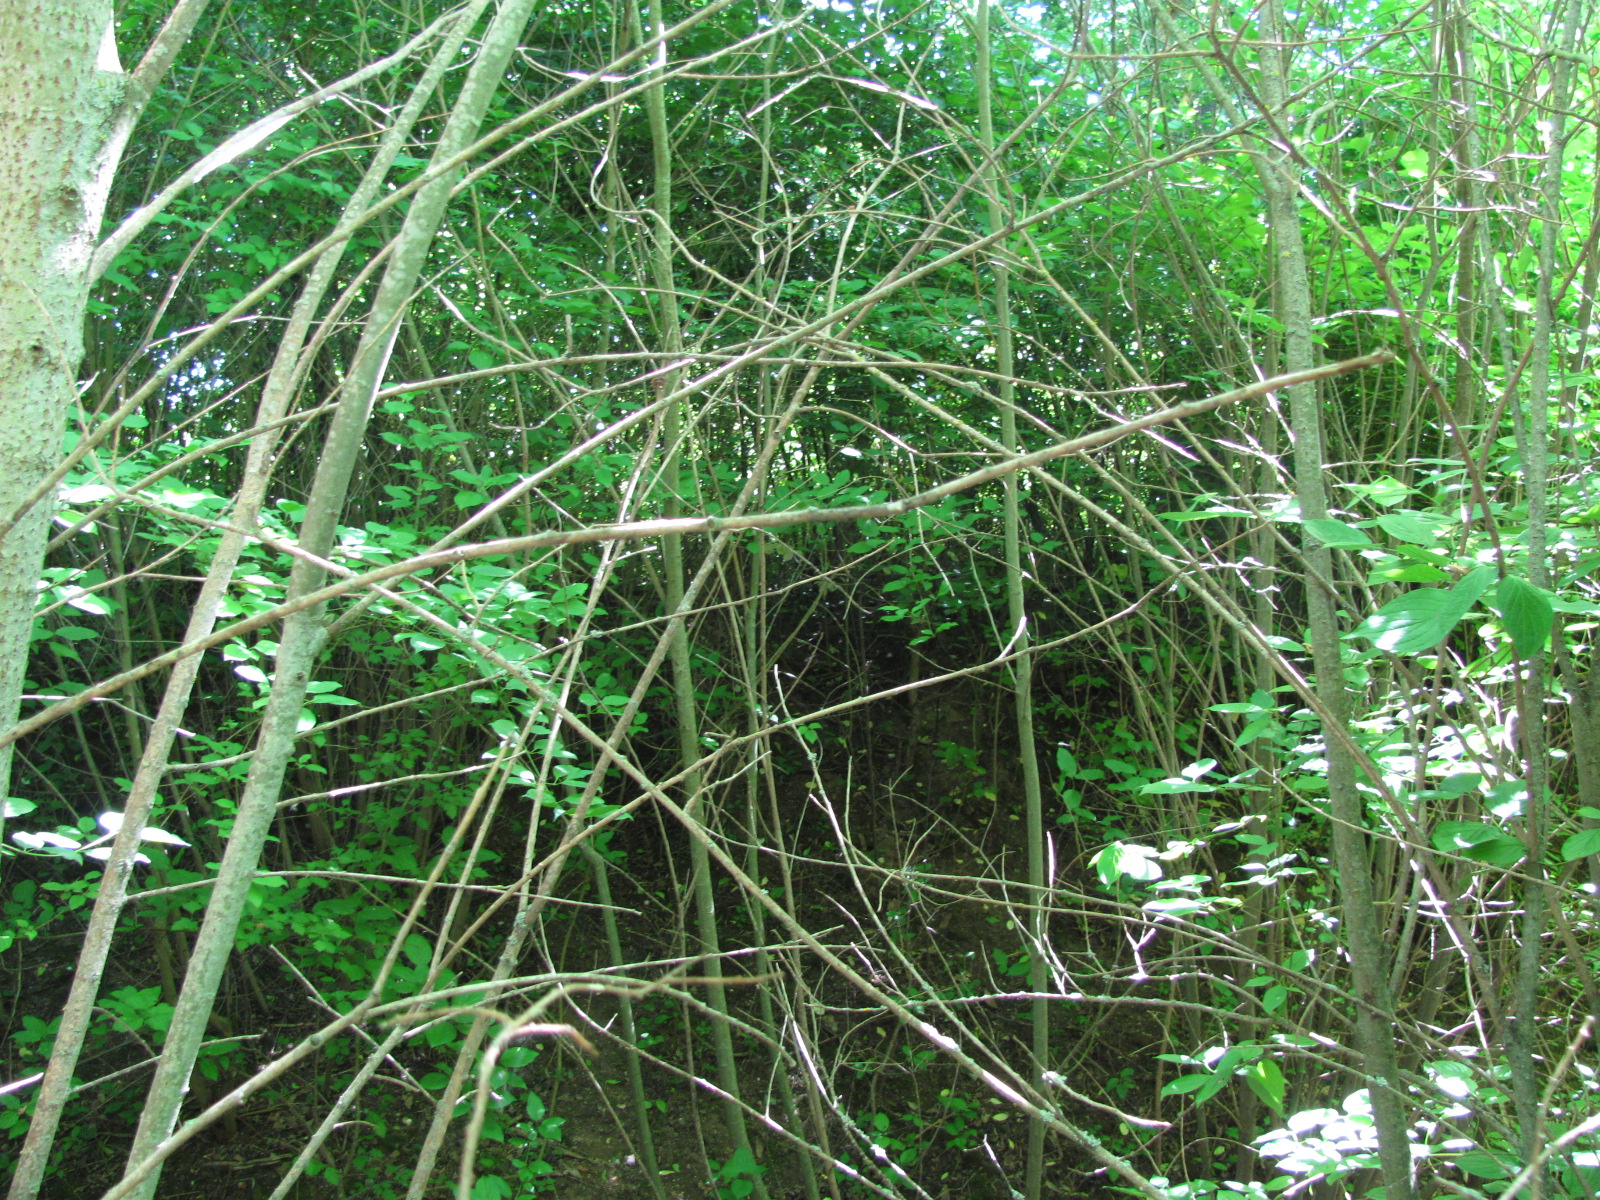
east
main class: Woodland
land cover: Broadleaved woodland
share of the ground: > 75 %
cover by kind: broadleaved forest trees 100 %
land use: Semi-natural and natural areas not in use
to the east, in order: Broadleaved woodland; Ditches and canals; Broadleaved woodland; Grassland with sparse tree/shrub cover; Common wheat
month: July
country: LV
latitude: 56.5067
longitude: 23.7114
